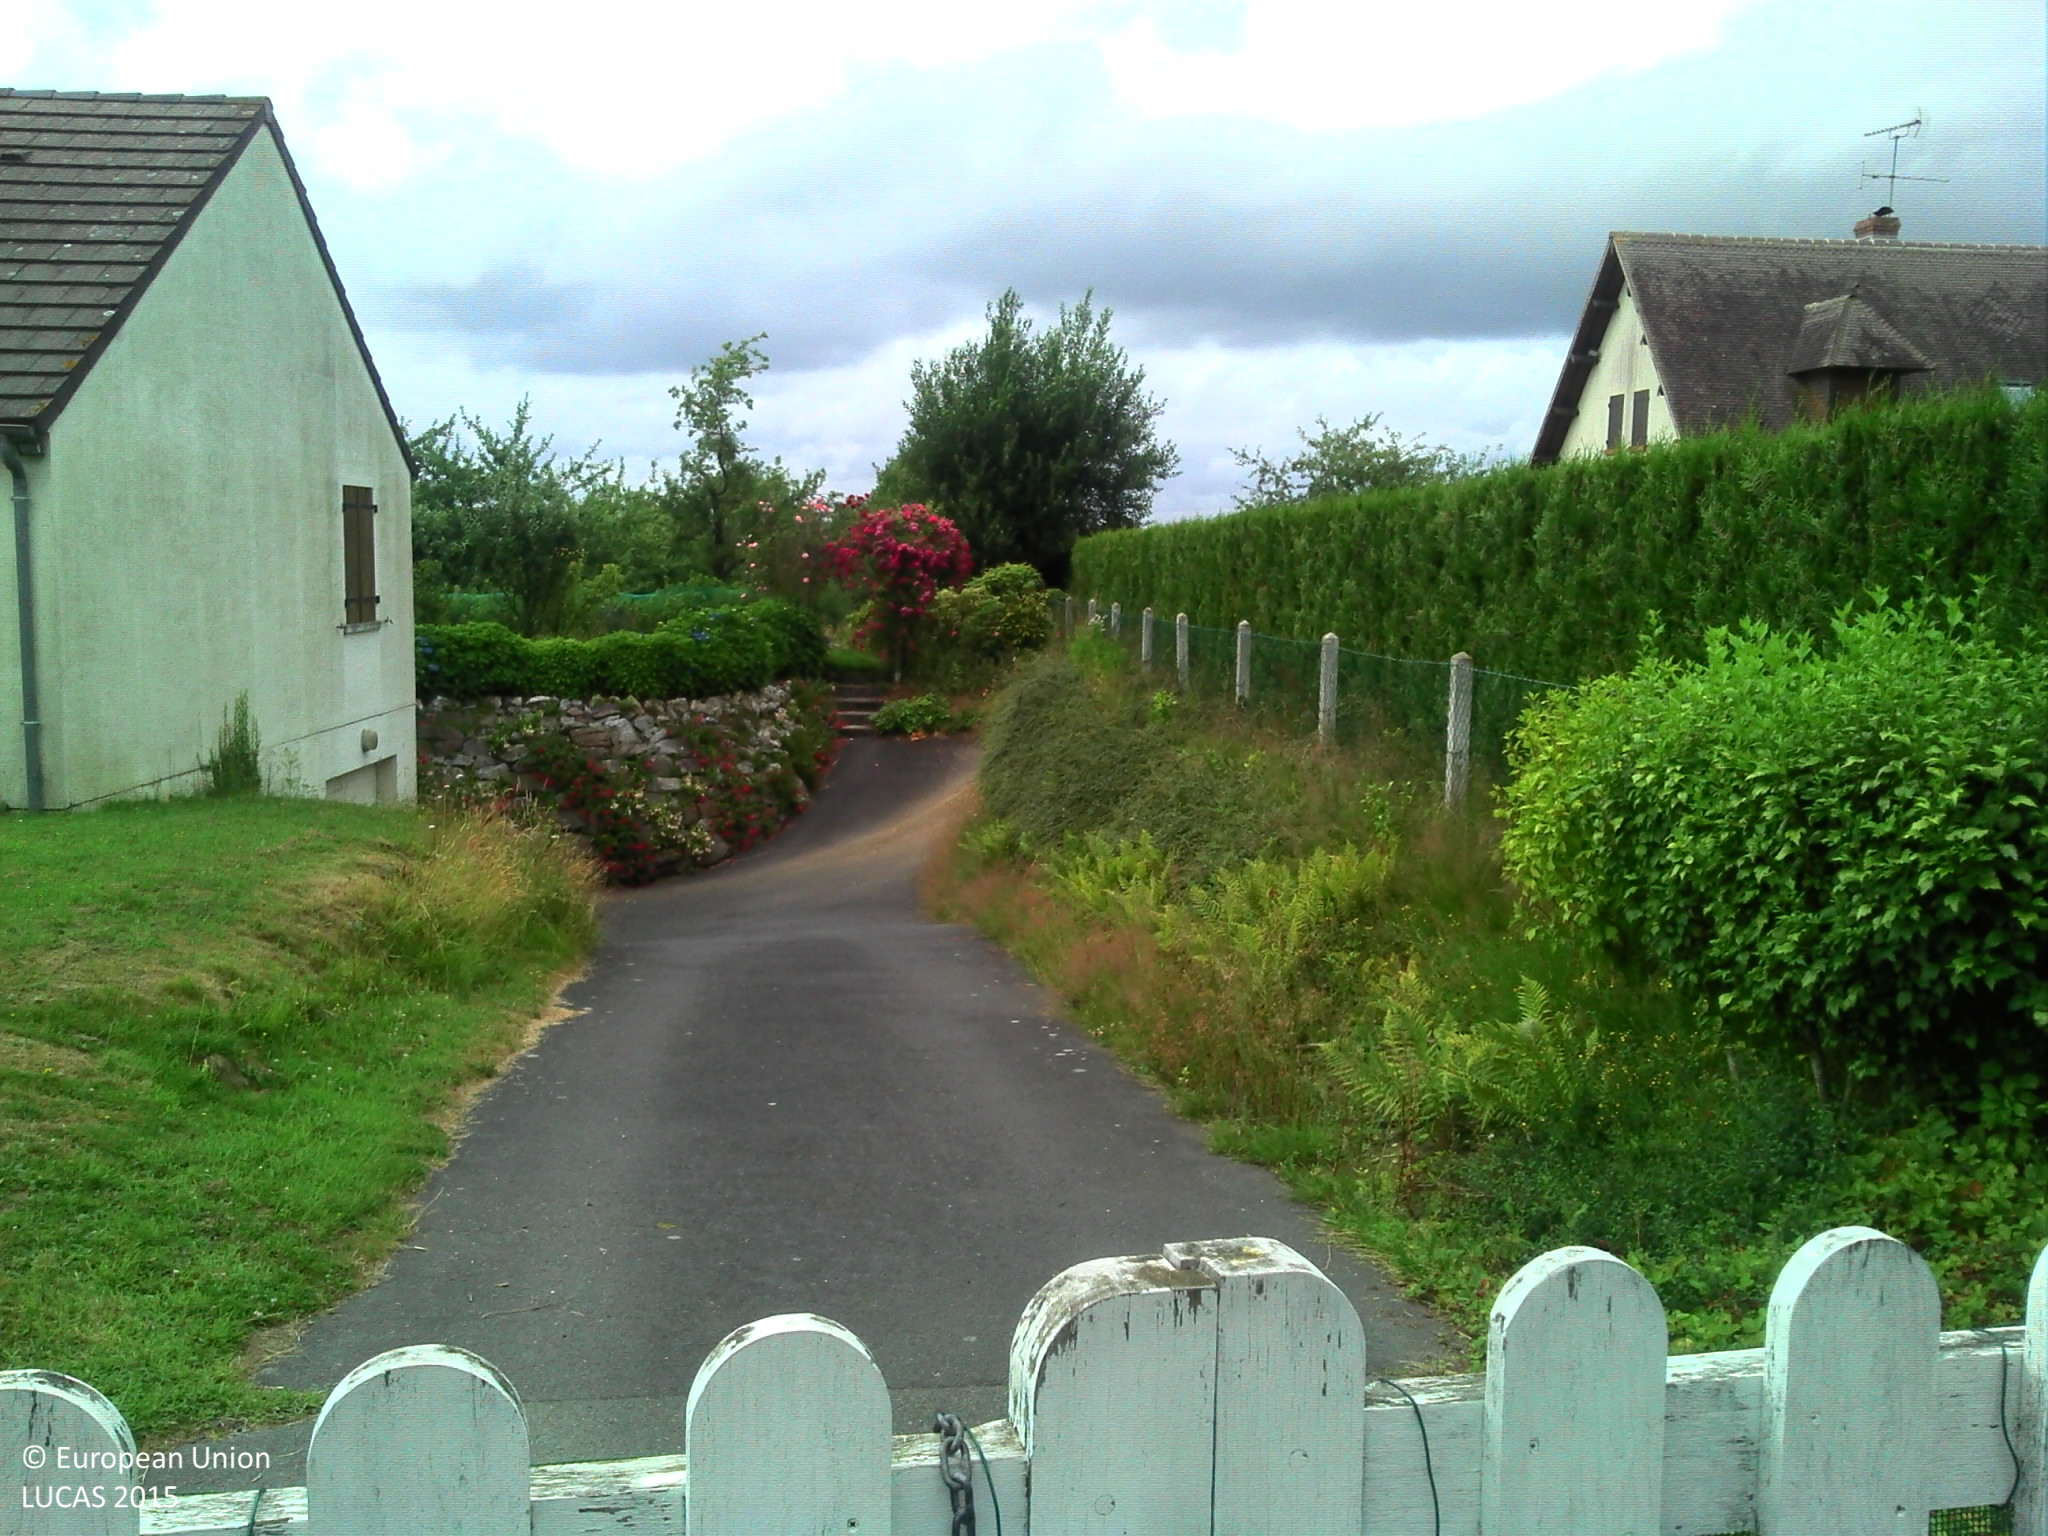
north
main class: Grassland
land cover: Grassland with sparse tree/shrub cover
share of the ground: > 75 %
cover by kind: herbaceous plants 95 %, broadleaved forest trees 5 %
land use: Residential
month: July
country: FR
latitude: 49.2528
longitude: 0.3969
